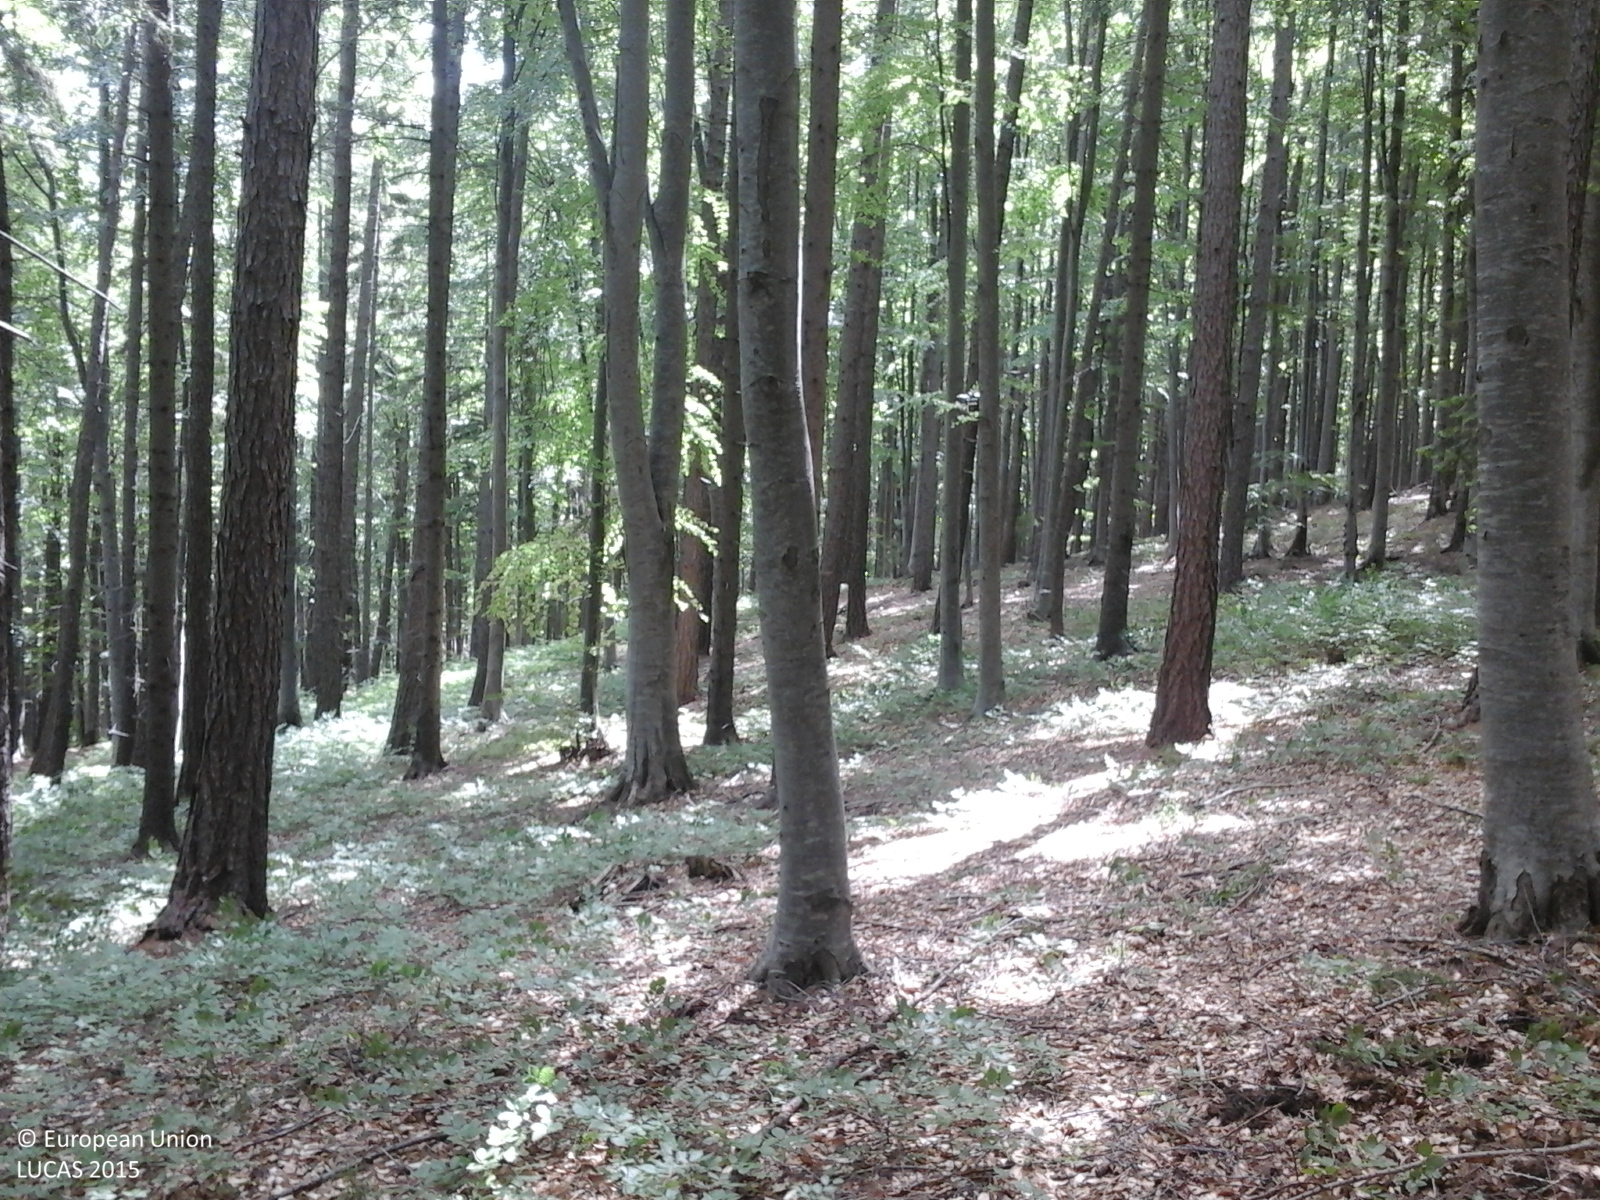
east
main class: Woodland
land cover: Spruce dominated mixed woodland
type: alpine coniferous forest
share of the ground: > 75 %
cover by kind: coniferous forest trees 60 %, broadleaved forest trees 40 %
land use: Forestry
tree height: > 5 m
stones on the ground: < 10 %
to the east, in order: Spruce dominated mixed woodland; Tracks; Spruce dominated mixed woodland
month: May
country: RO
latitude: 45.3076
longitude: 25.9637
